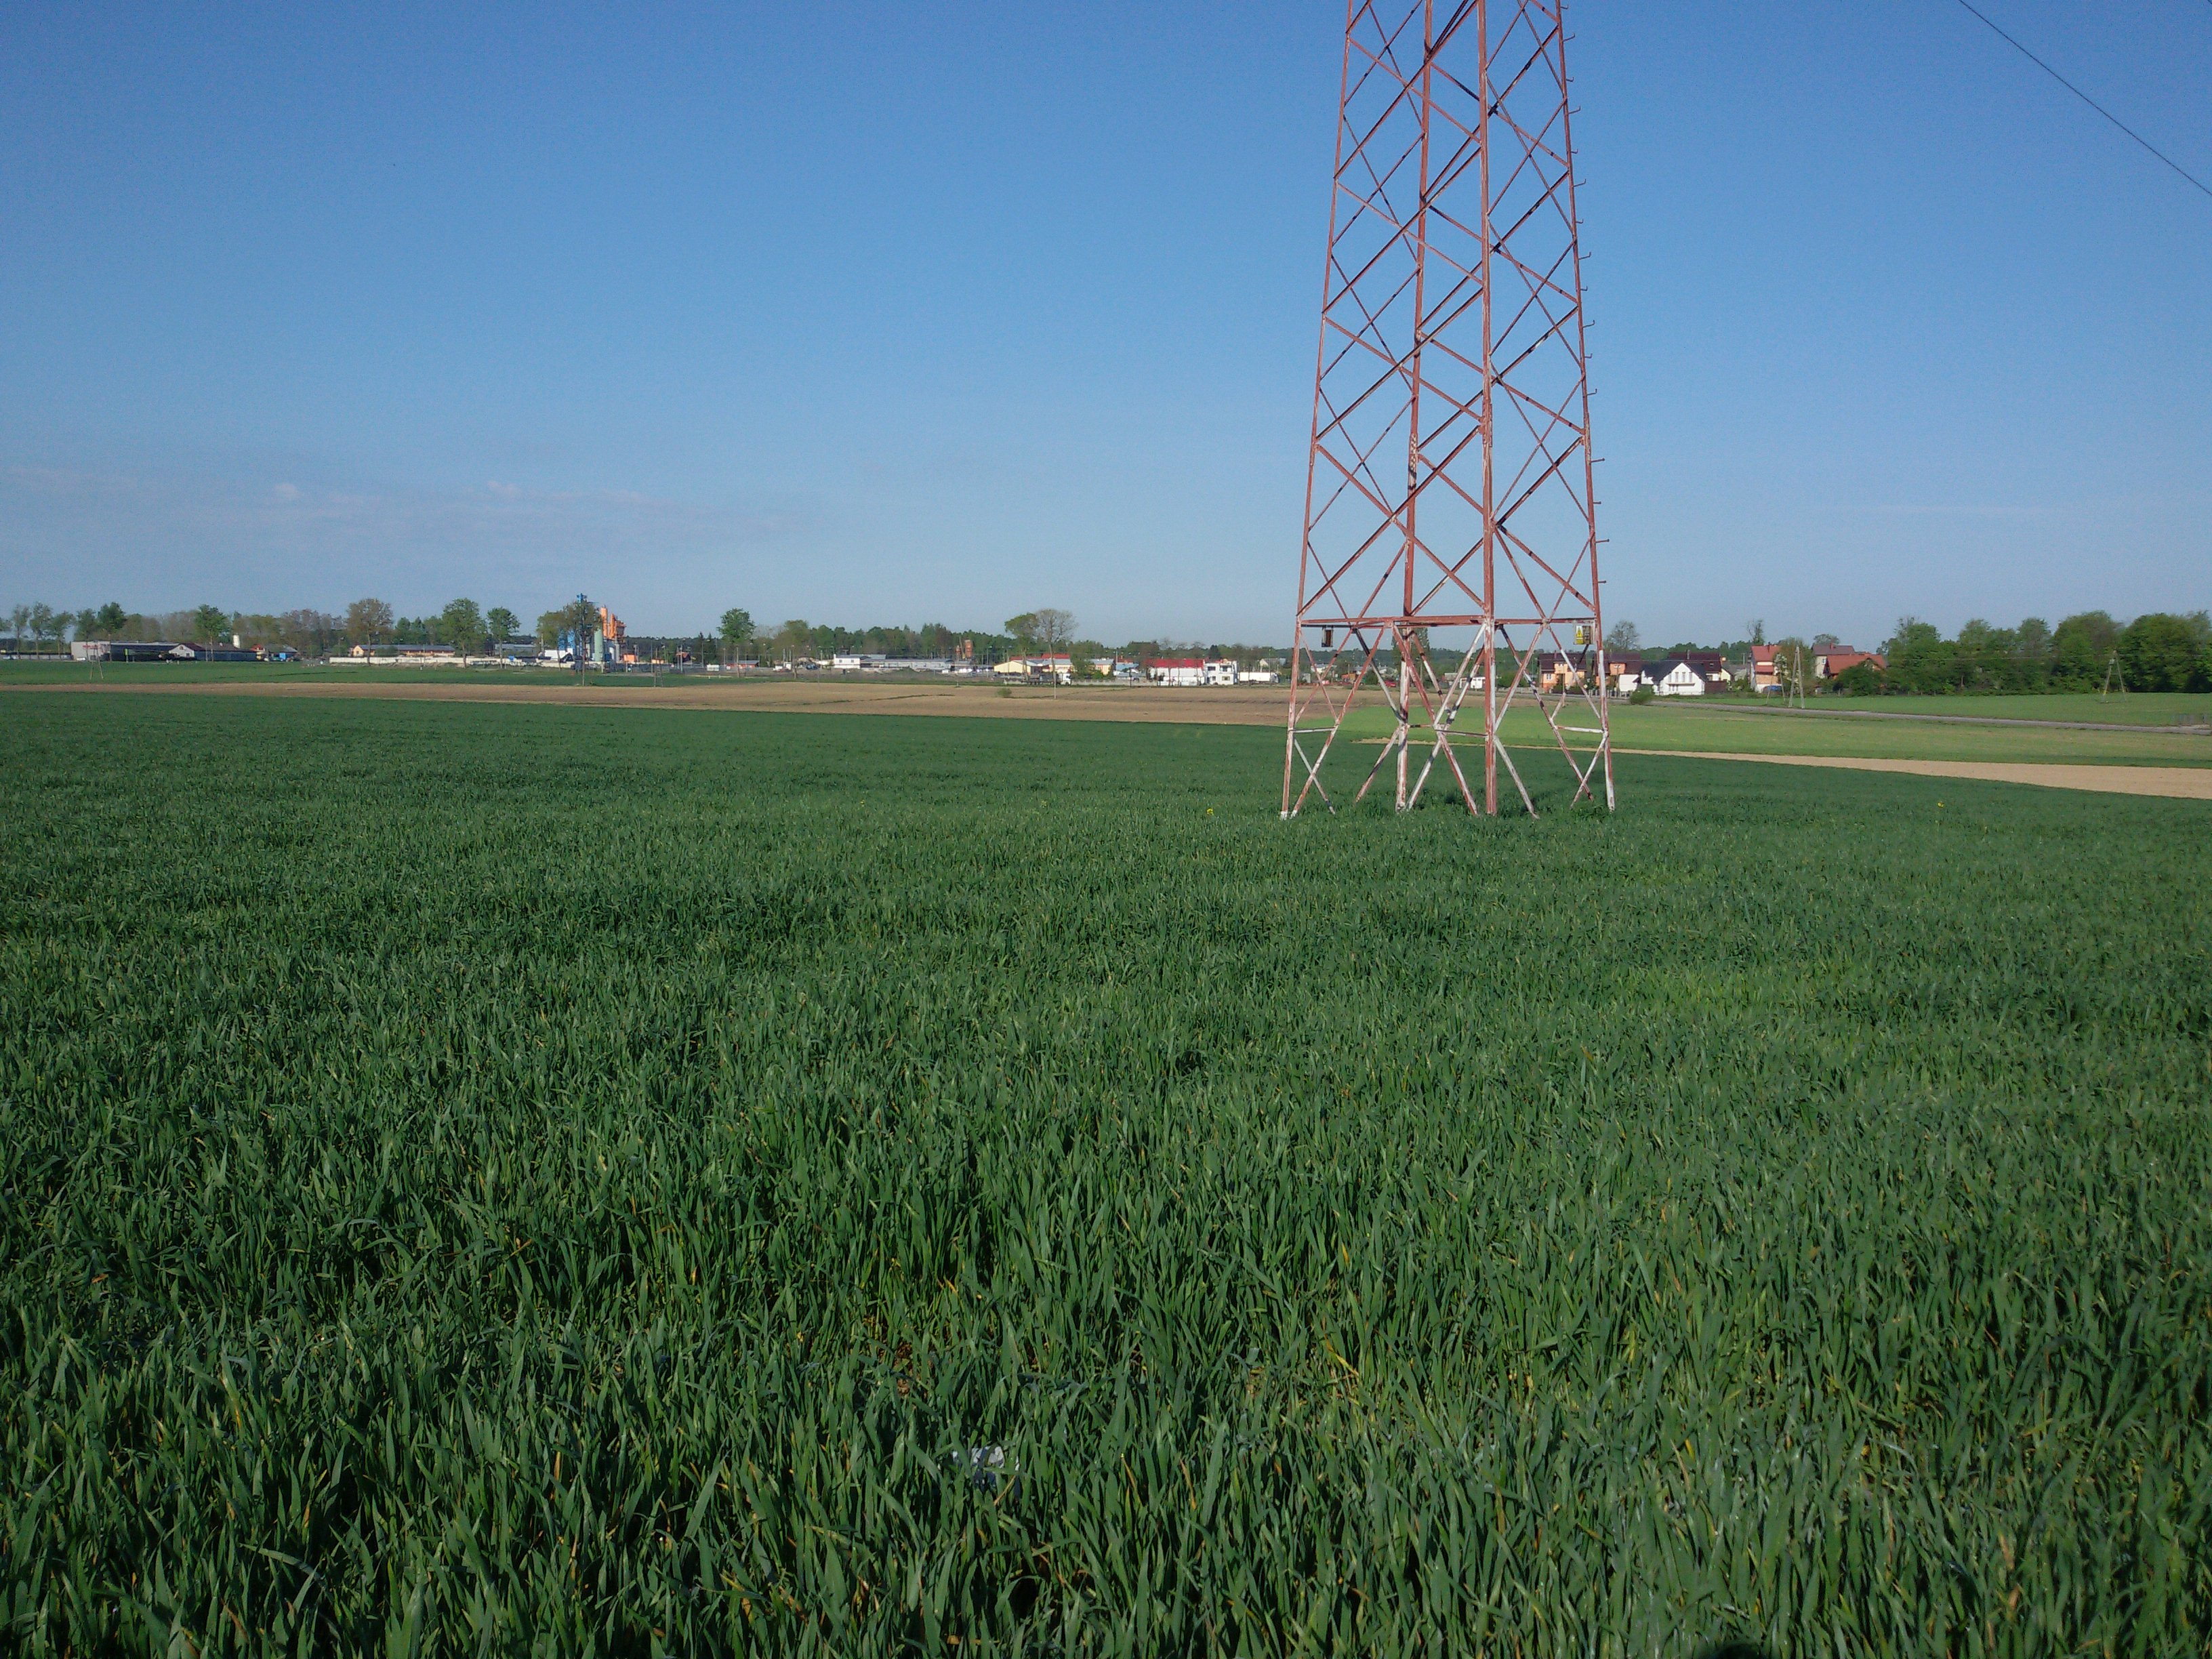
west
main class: Cropland
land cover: Oats
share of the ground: > 75 %
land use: Agriculture (excluding fallow land and kitchen gardens)
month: May
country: PL
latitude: 52.9586
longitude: 22.2539
